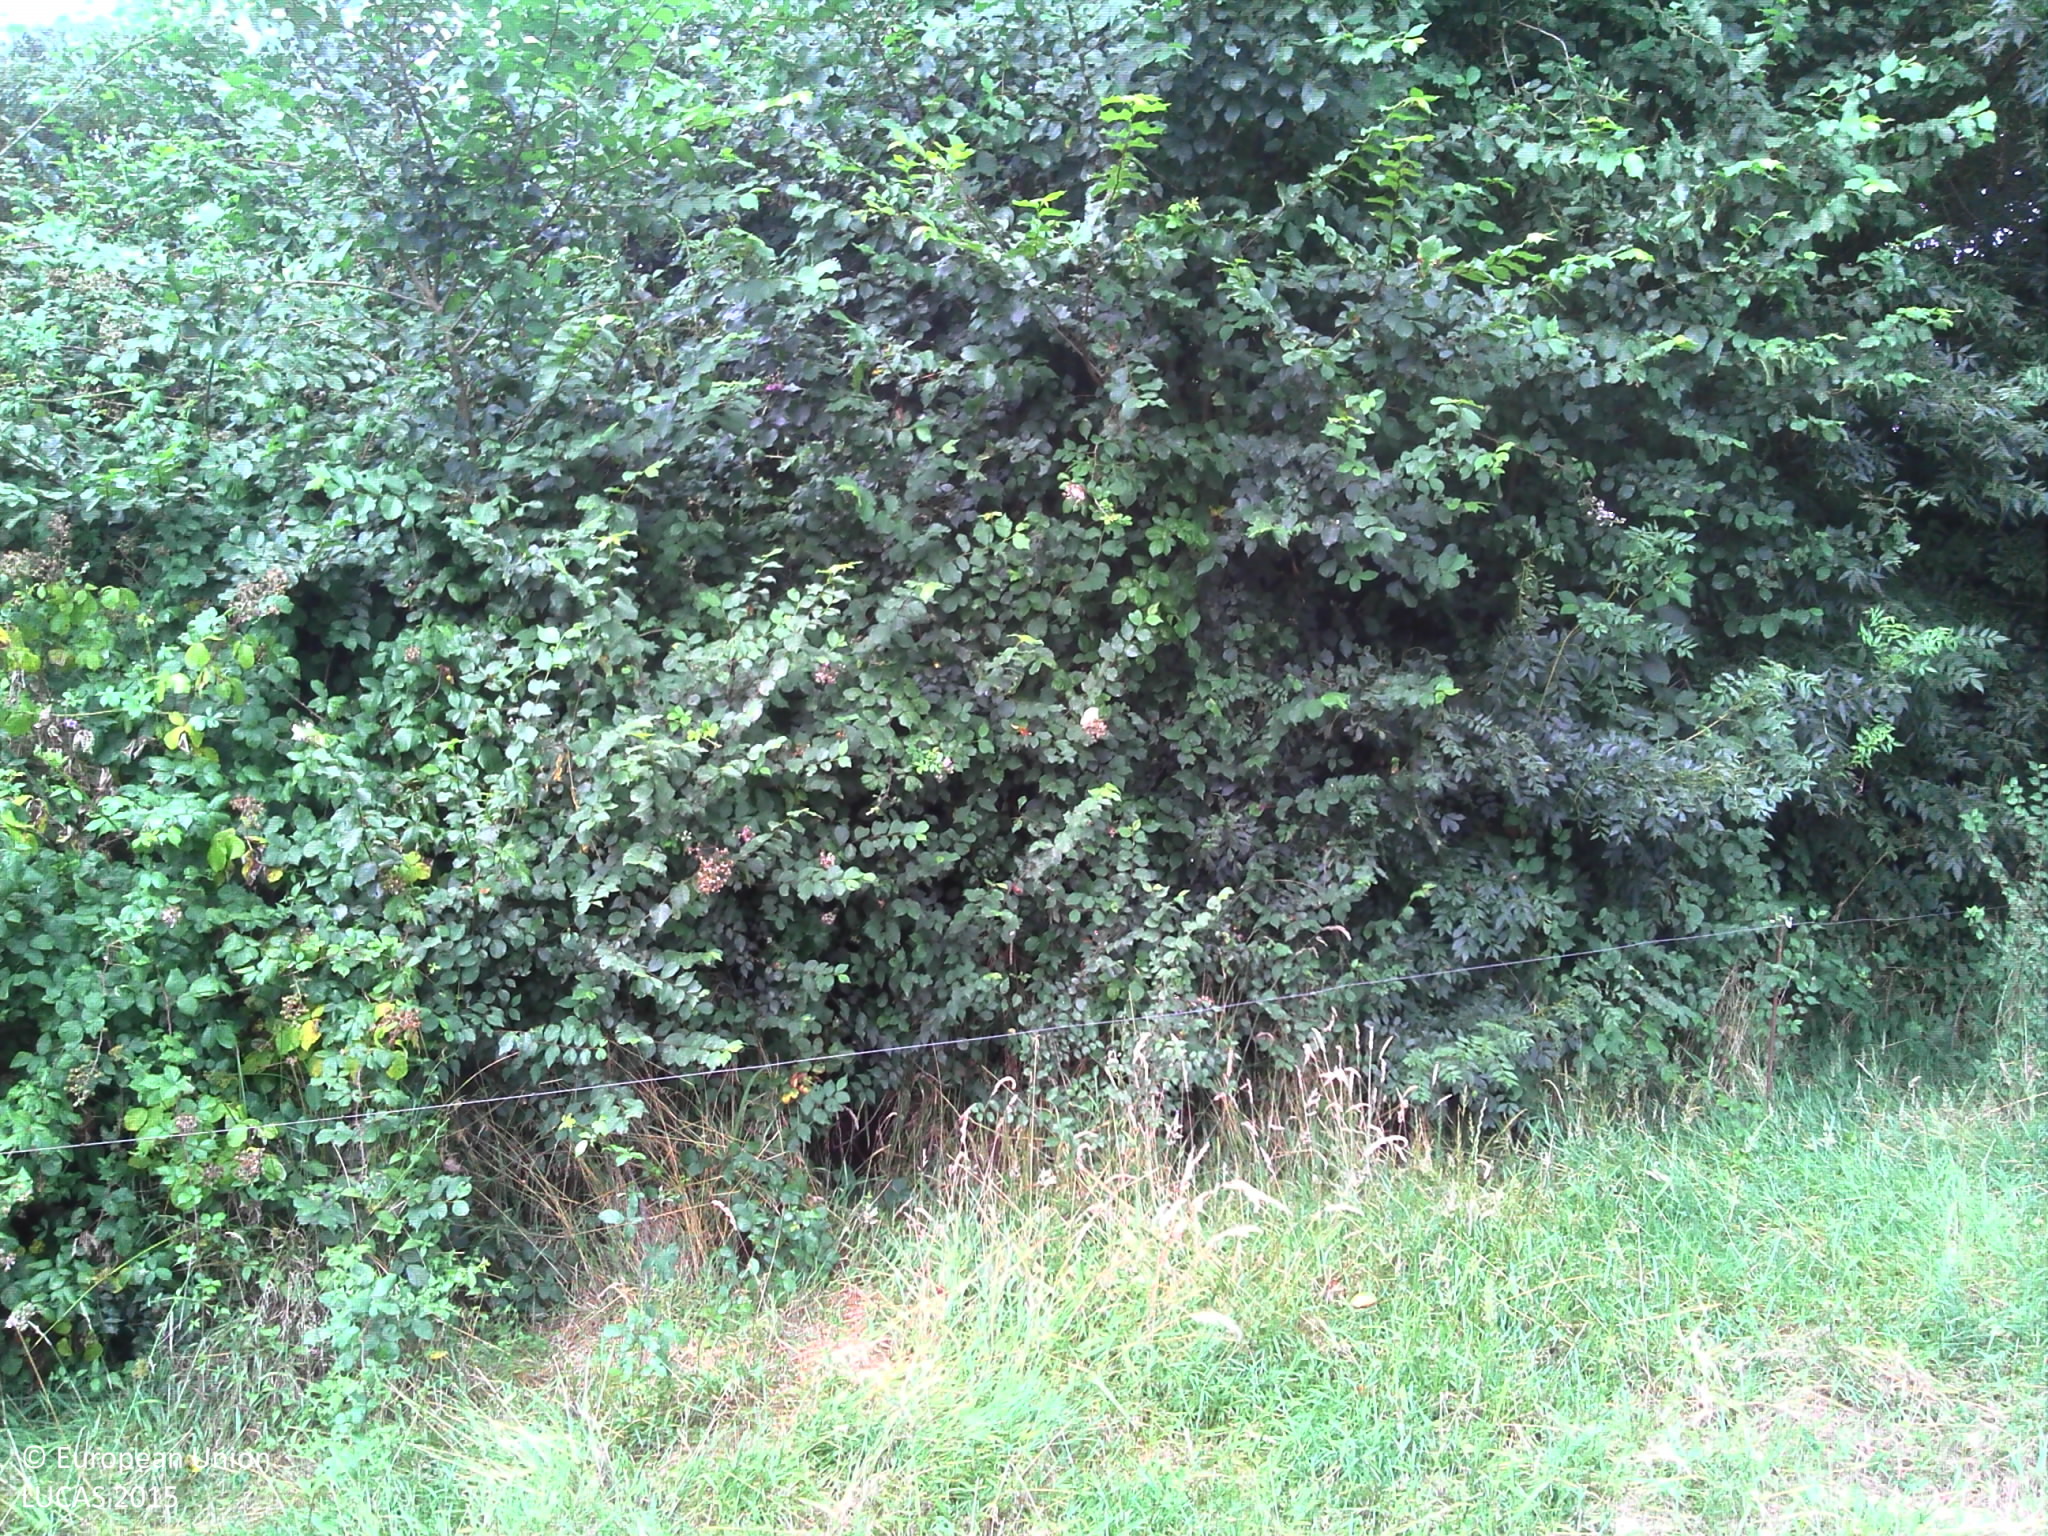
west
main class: Grassland
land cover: Grassland without tree/shrub cover
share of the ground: > 75 %
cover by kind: herbaceous plants 100 %
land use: Agriculture (excluding fallow land and kitchen gardens)
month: July
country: FR
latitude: 47.0533
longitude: -1.6935
